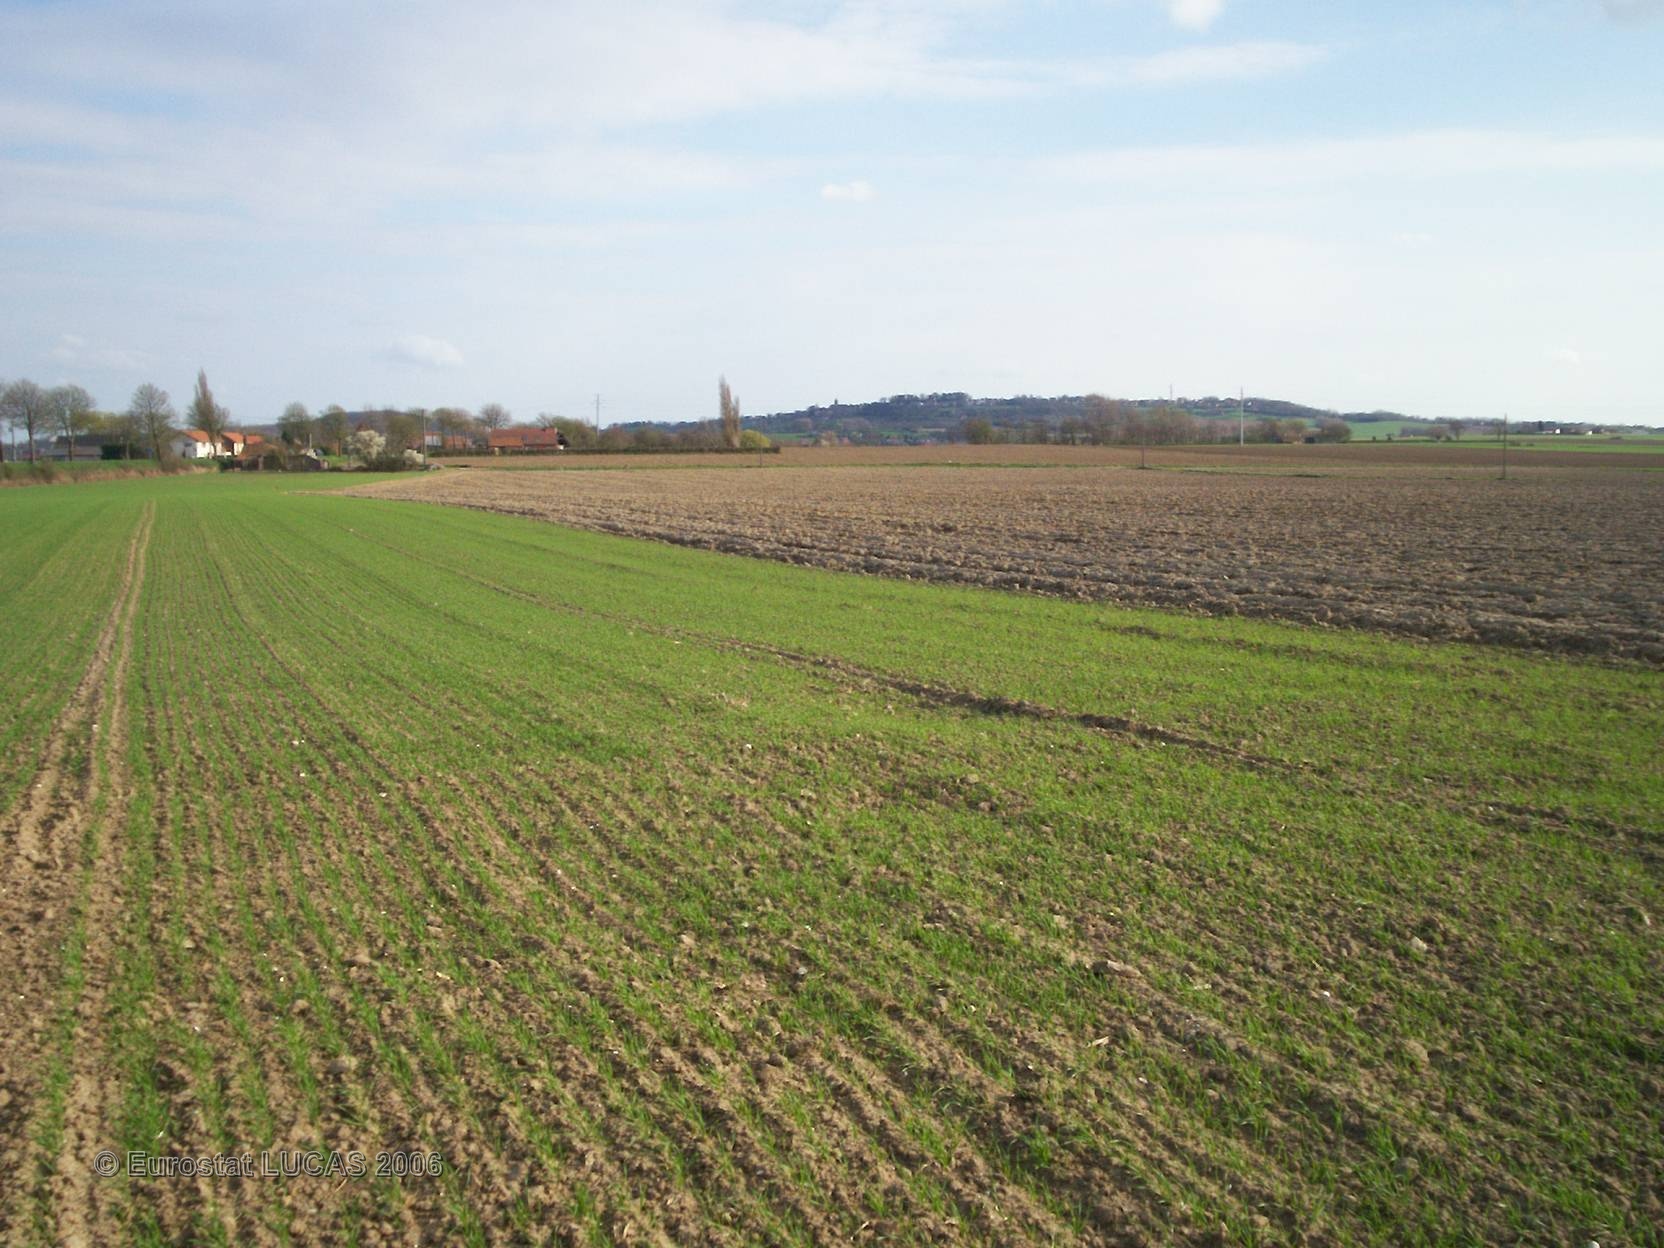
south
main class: Cropland
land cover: Common wheat
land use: Agriculture (excluding fallow land and kitchen gardens)
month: April
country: FR
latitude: 50.8384
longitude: 2.4751
